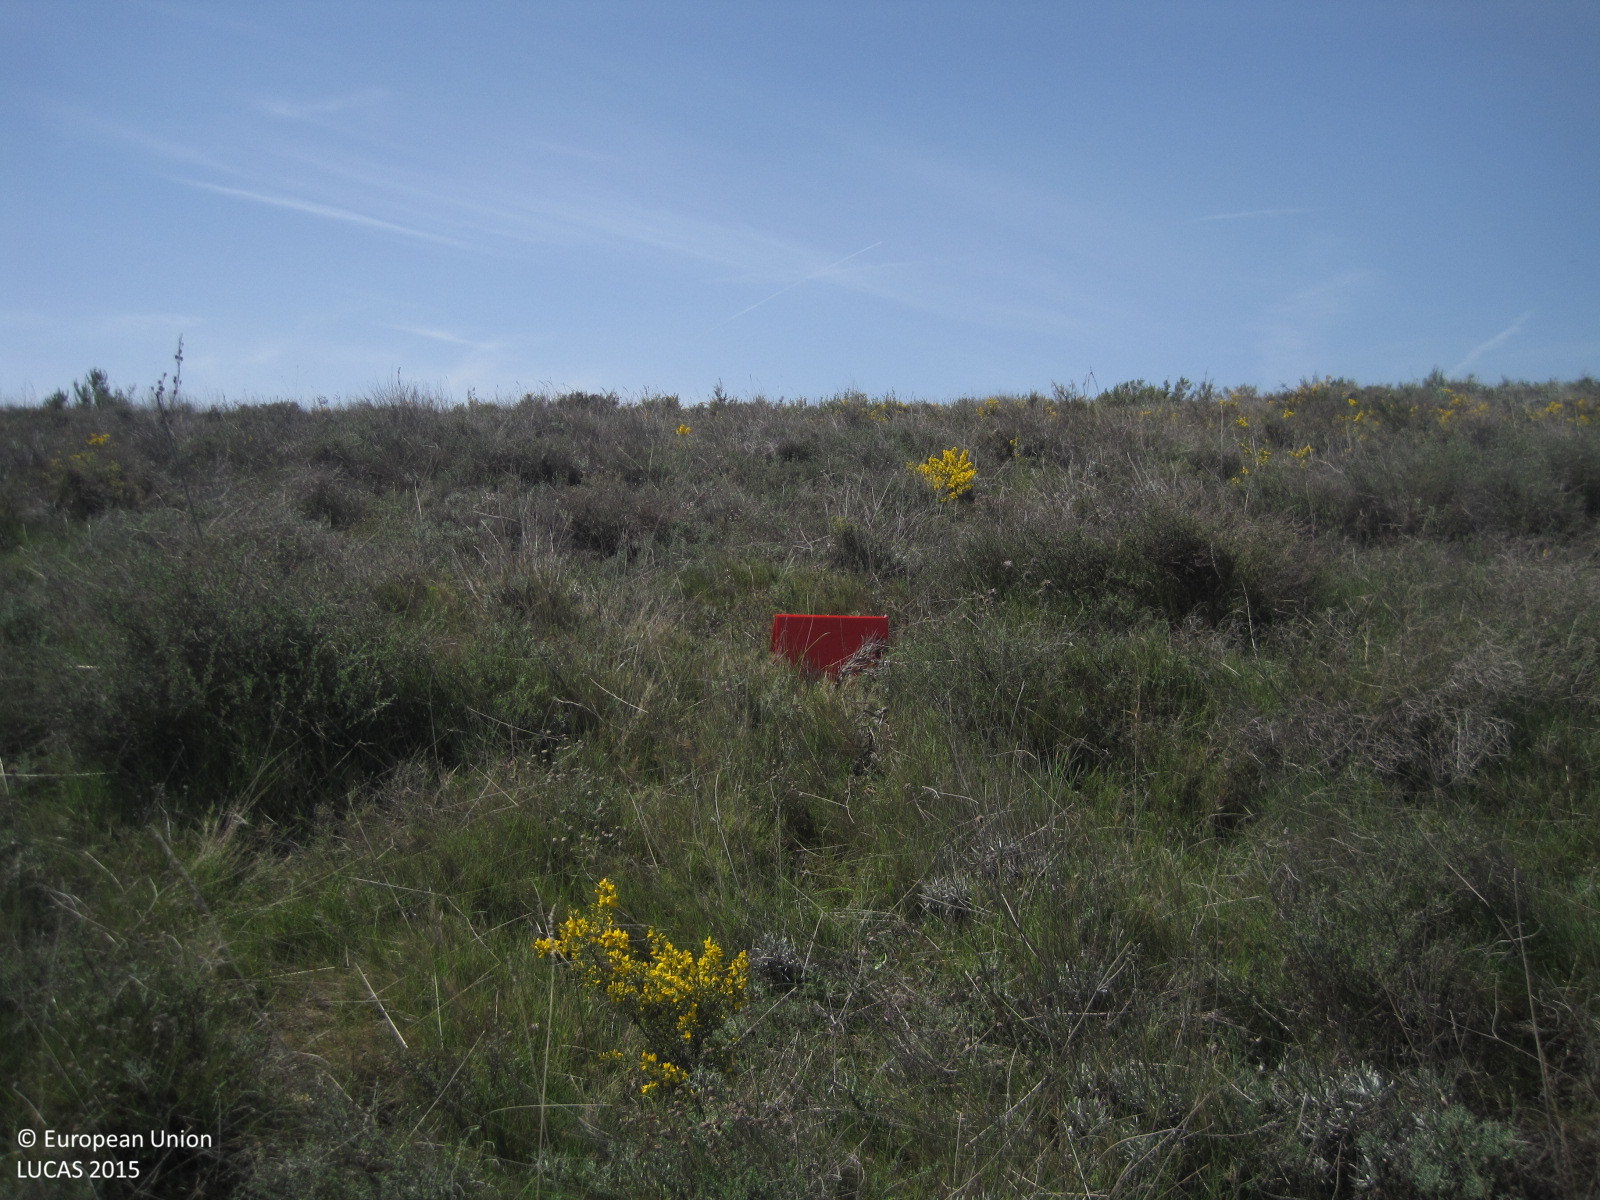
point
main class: Shrubland
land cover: Shrubland without tree cover
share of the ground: > 75 %
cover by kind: shrubs 60 %, herbaceous plants 40 %
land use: Semi-natural and natural areas not in use
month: April
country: ES
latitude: 42.5244
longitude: -2.2775
